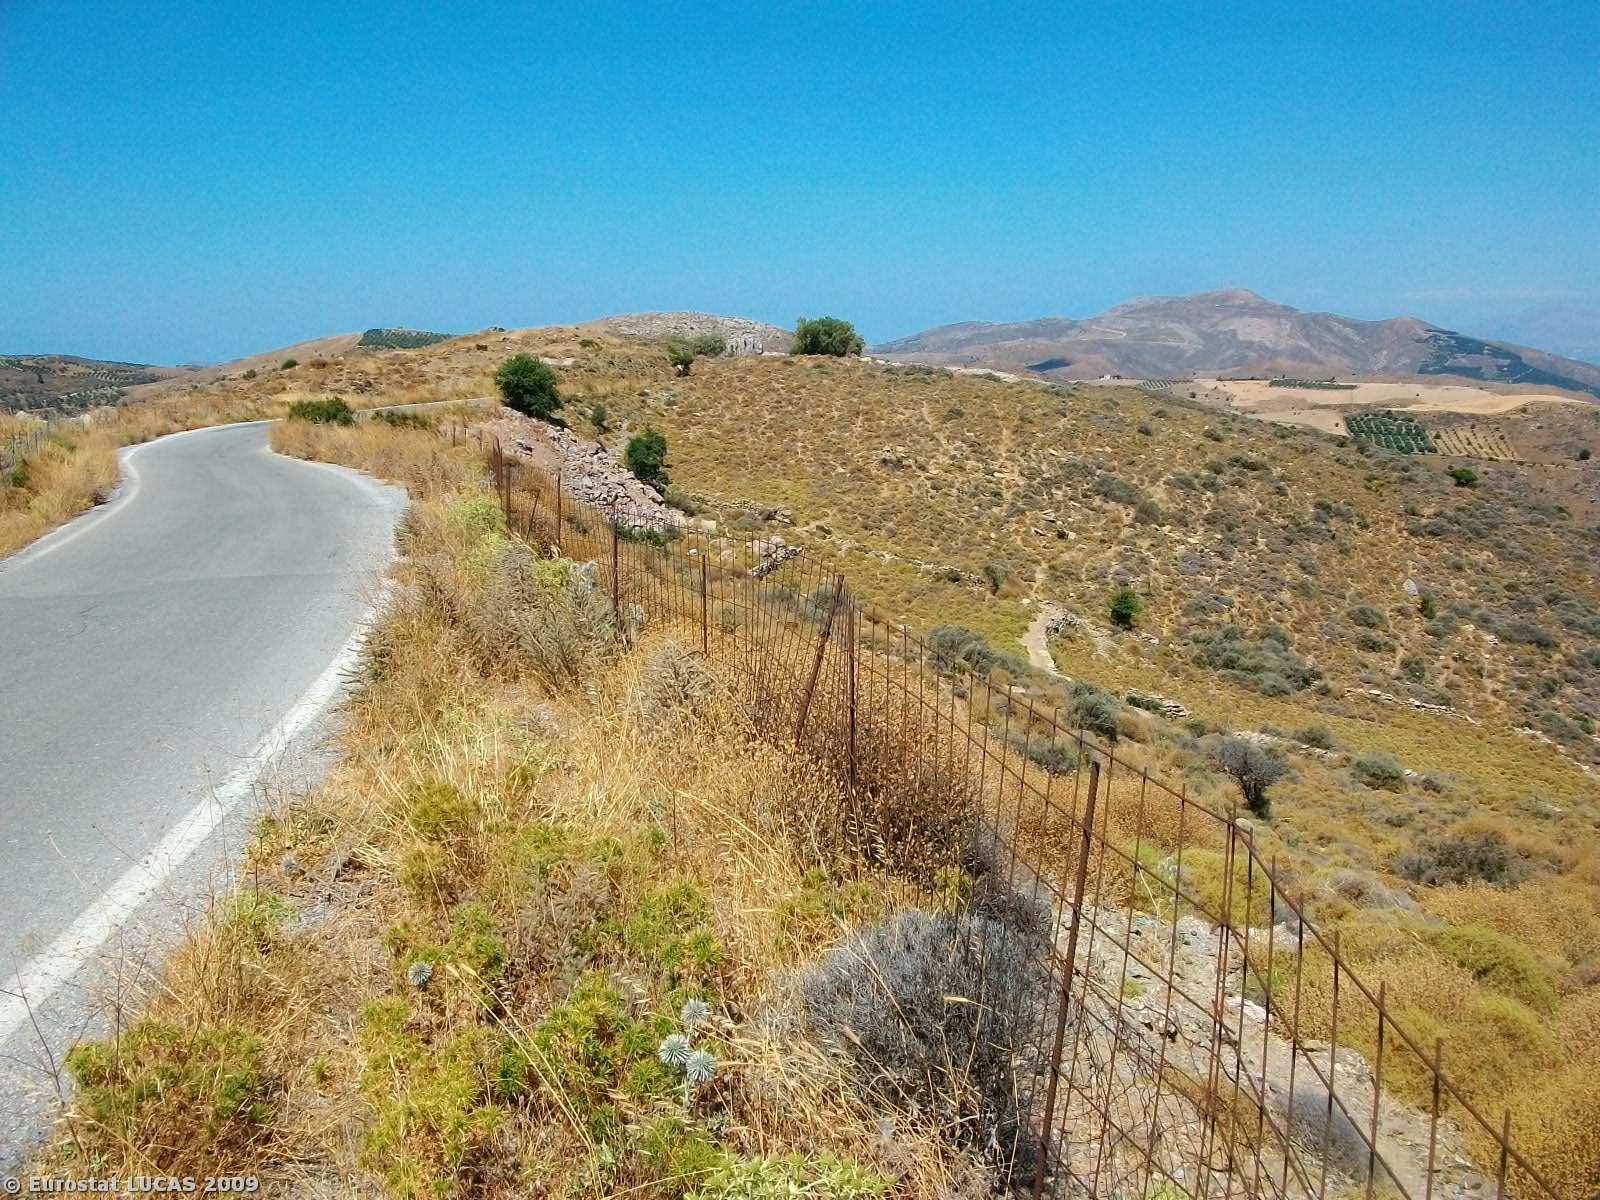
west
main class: Shrubland
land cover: Shrubland without tree cover
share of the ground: > 75 %
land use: Agriculture (excluding fallow land and kitchen gardens)
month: July
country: GR
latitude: 34.9763
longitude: 24.9355
